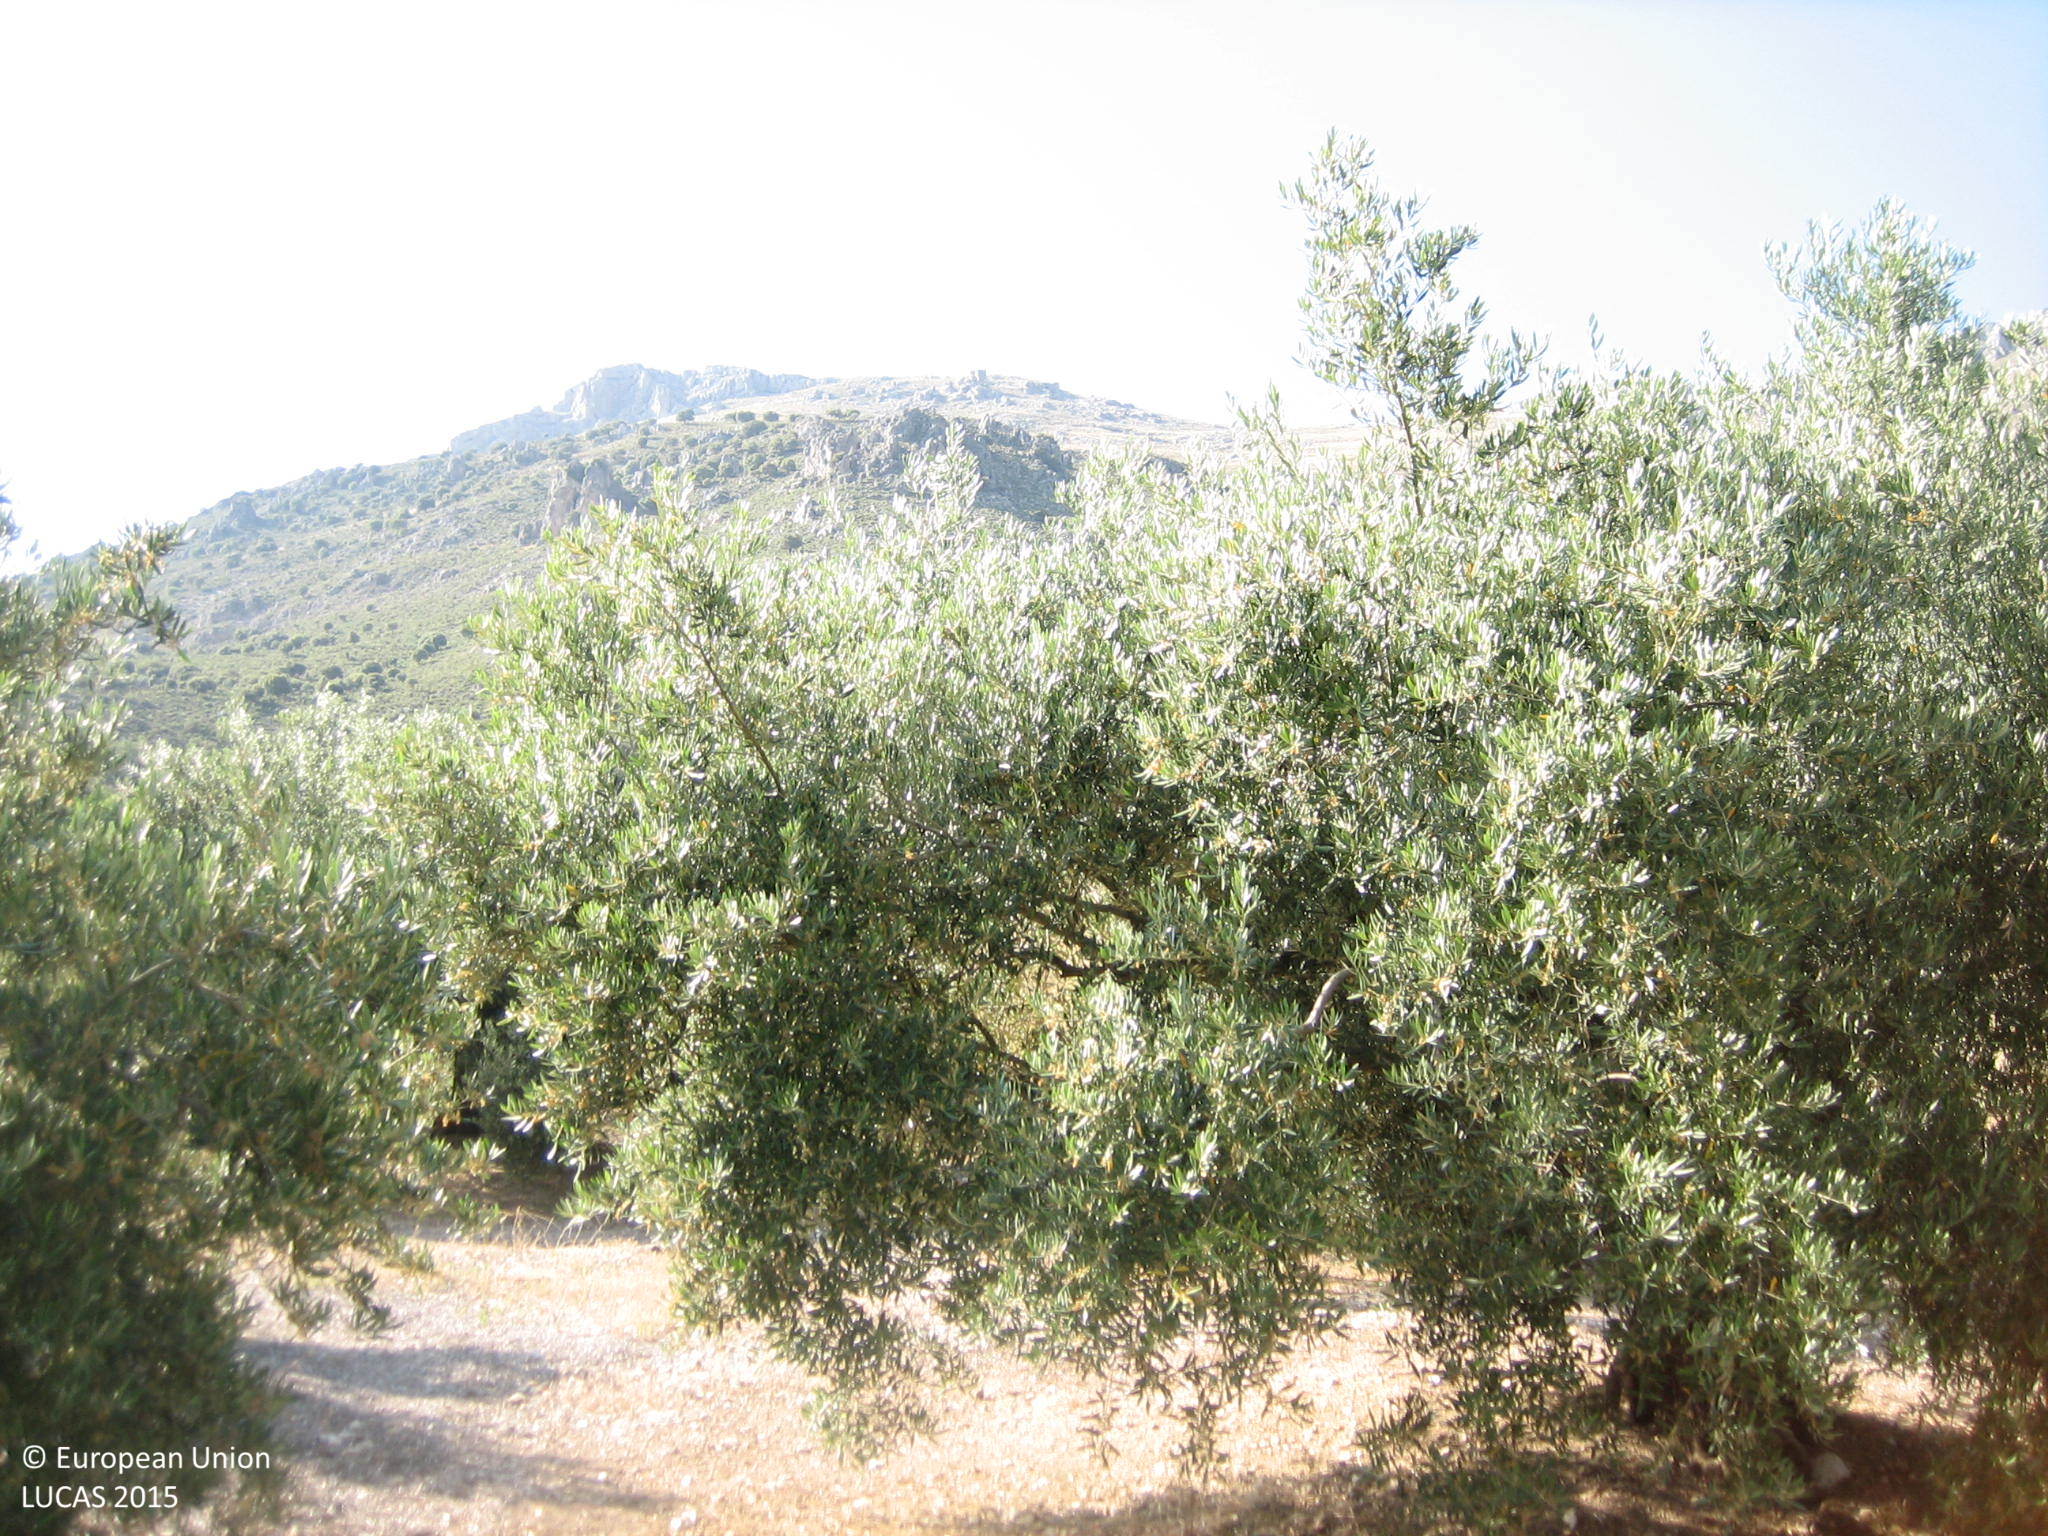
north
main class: Cropland
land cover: Olive groves
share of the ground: 25 - 50 %
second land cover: Spontaneously vegetated surfaces
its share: 10 - 25 %
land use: Agriculture (excluding fallow land and kitchen gardens)
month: June
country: ES
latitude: 37.6197
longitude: -3.7864
